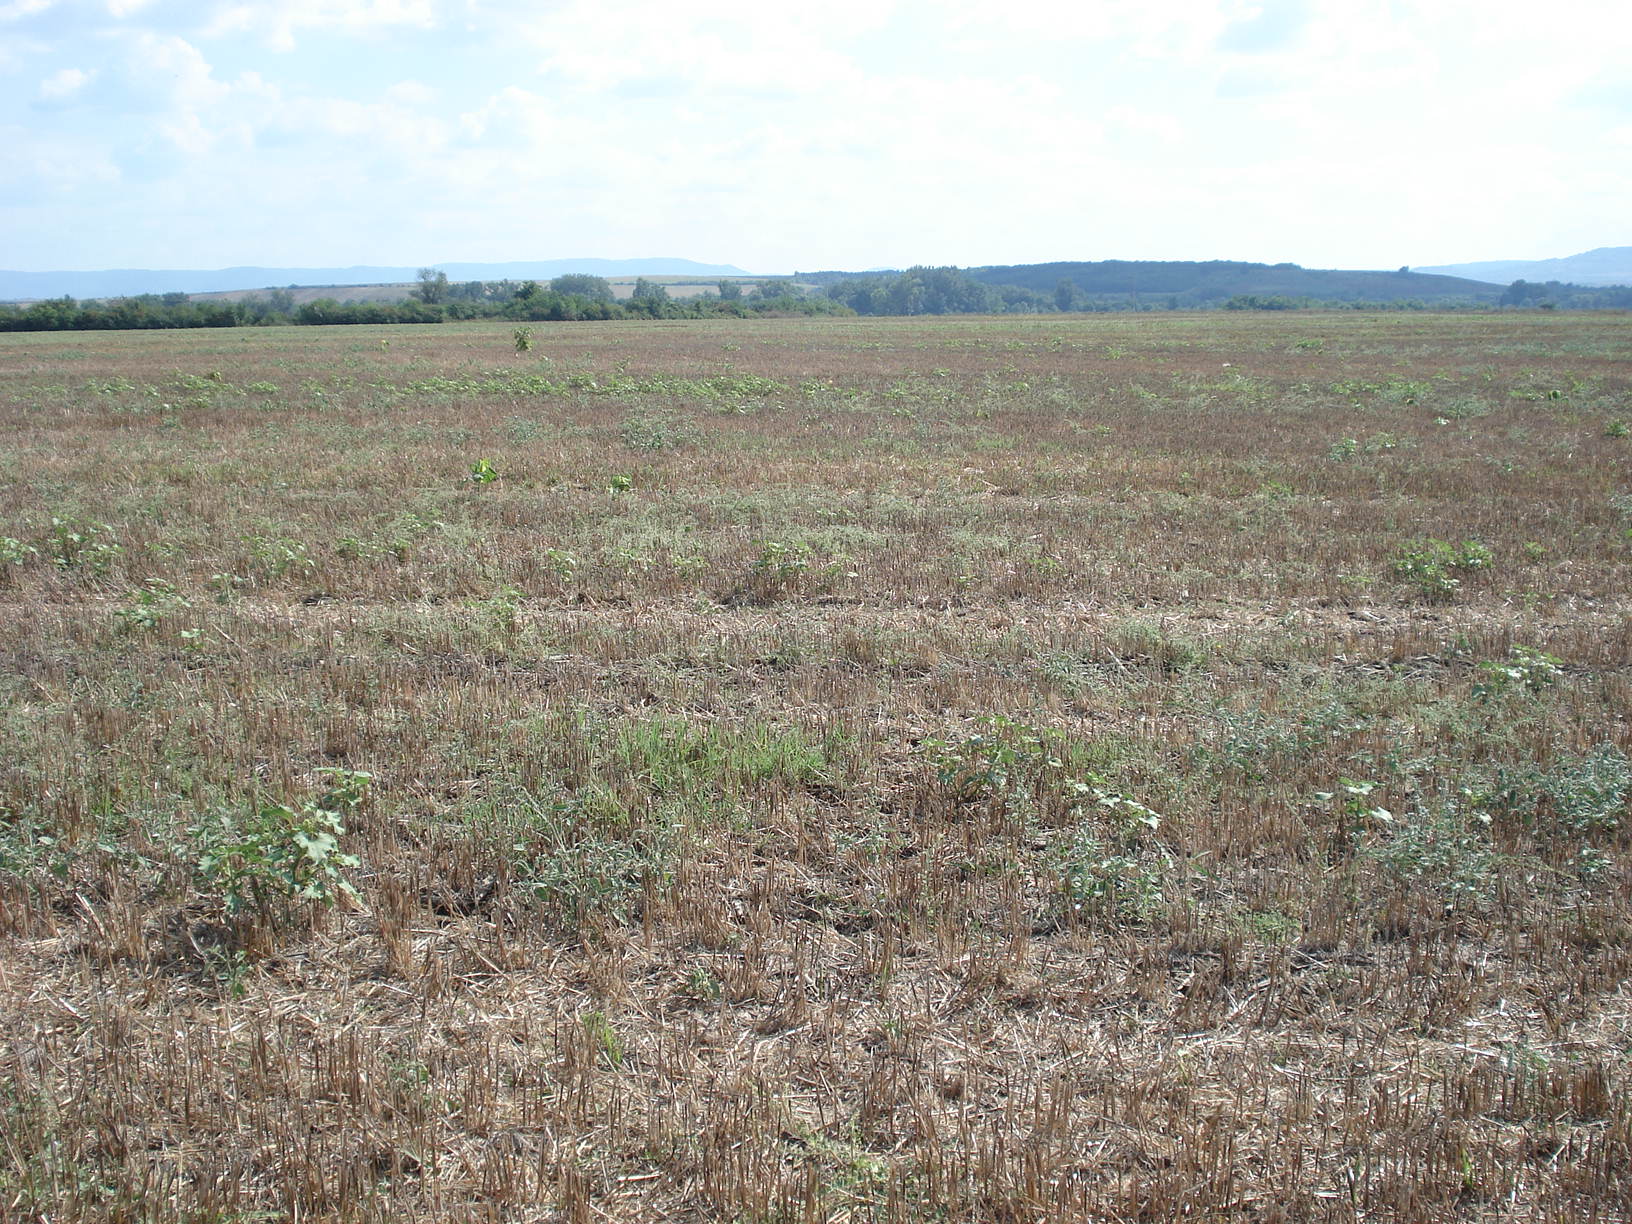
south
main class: Cropland
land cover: Common wheat
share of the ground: 50 - 75 %
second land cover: Spontaneously vegetated surfaces
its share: 25 - 50 %
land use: Agriculture (excluding fallow land and kitchen gardens)
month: August
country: BG
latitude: 43.1512
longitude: 25.7871
